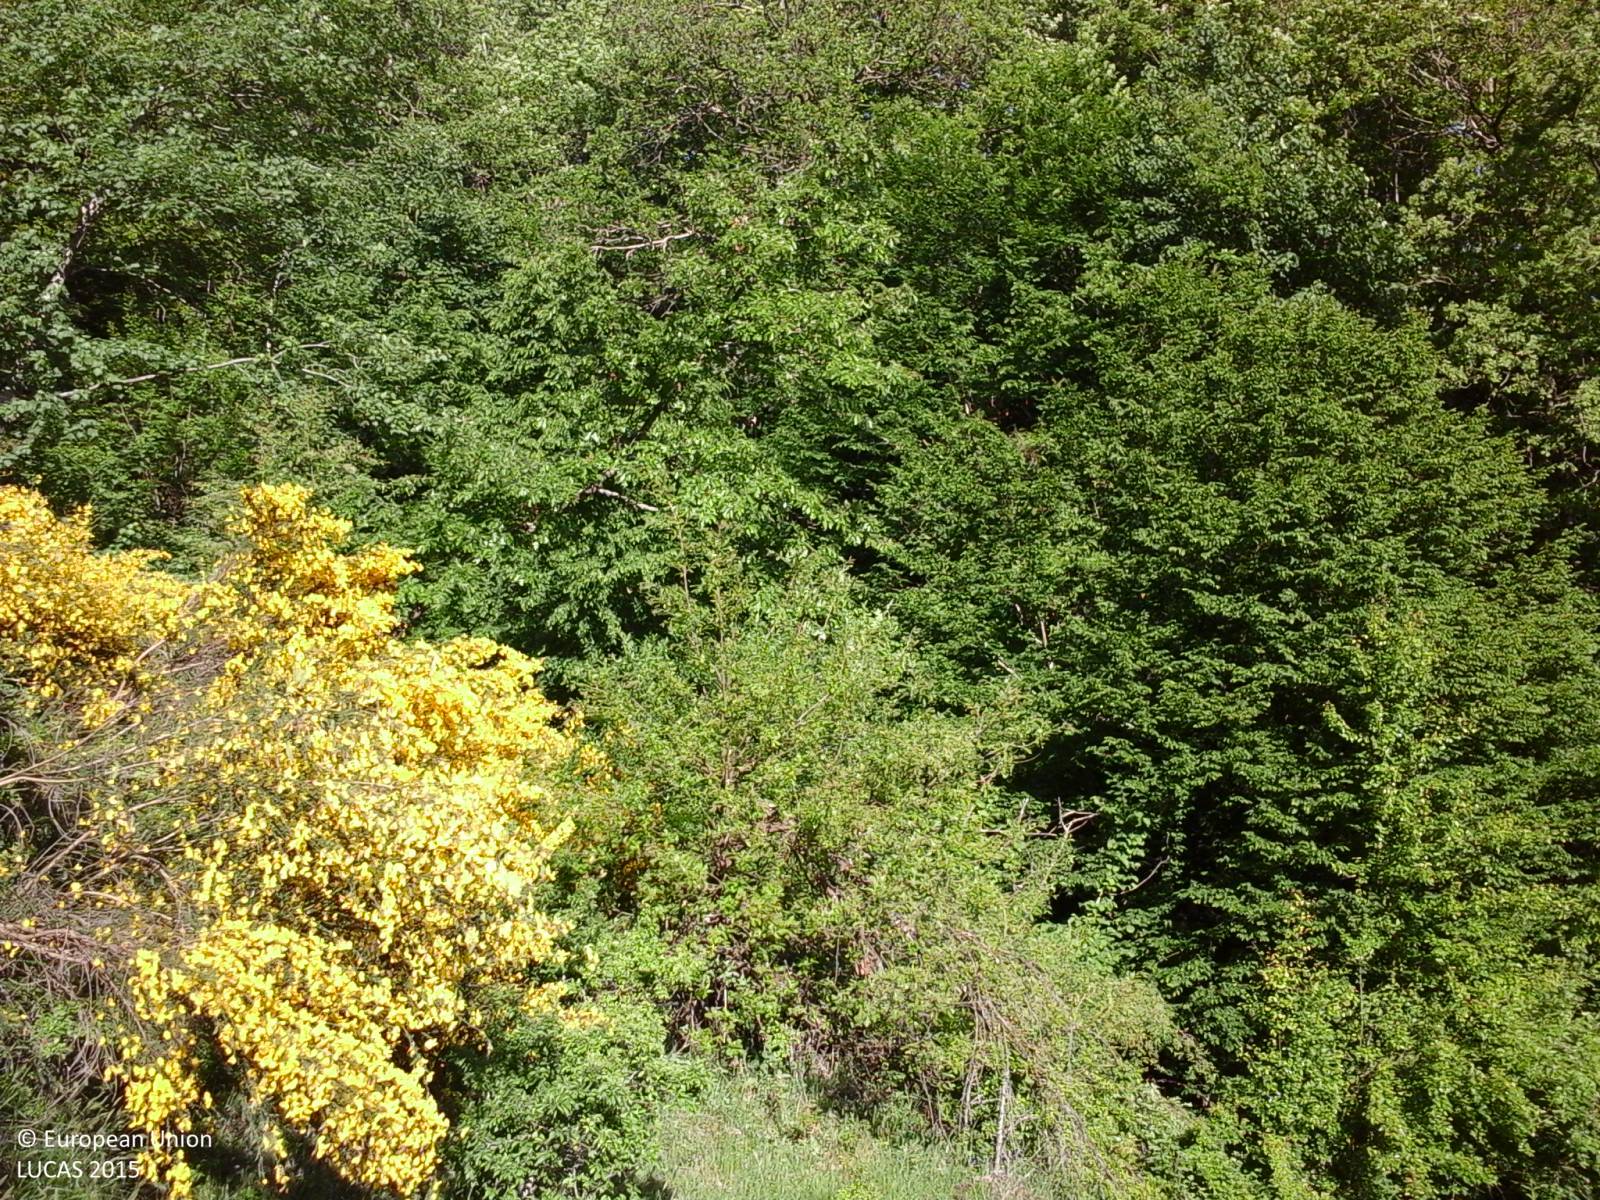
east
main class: Shrubland
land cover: Shrubland with sparse tree cover
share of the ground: > 75 %
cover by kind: shrubs 90 %, broadleaved forest trees 5 %, herbaceous plants 5 %
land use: Semi-natural and natural areas not in use
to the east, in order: Shrubland with sparse tree cover; Broadleaved woodland; Grassland with sparse tree/shrub cover; Tracks; Broadleaved woodland; Shrubland with sparse tree cover; Broadleaved woodland; Tracks; Broadleaved woodland
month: May
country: IT
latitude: 42.1352
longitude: 13.1469
